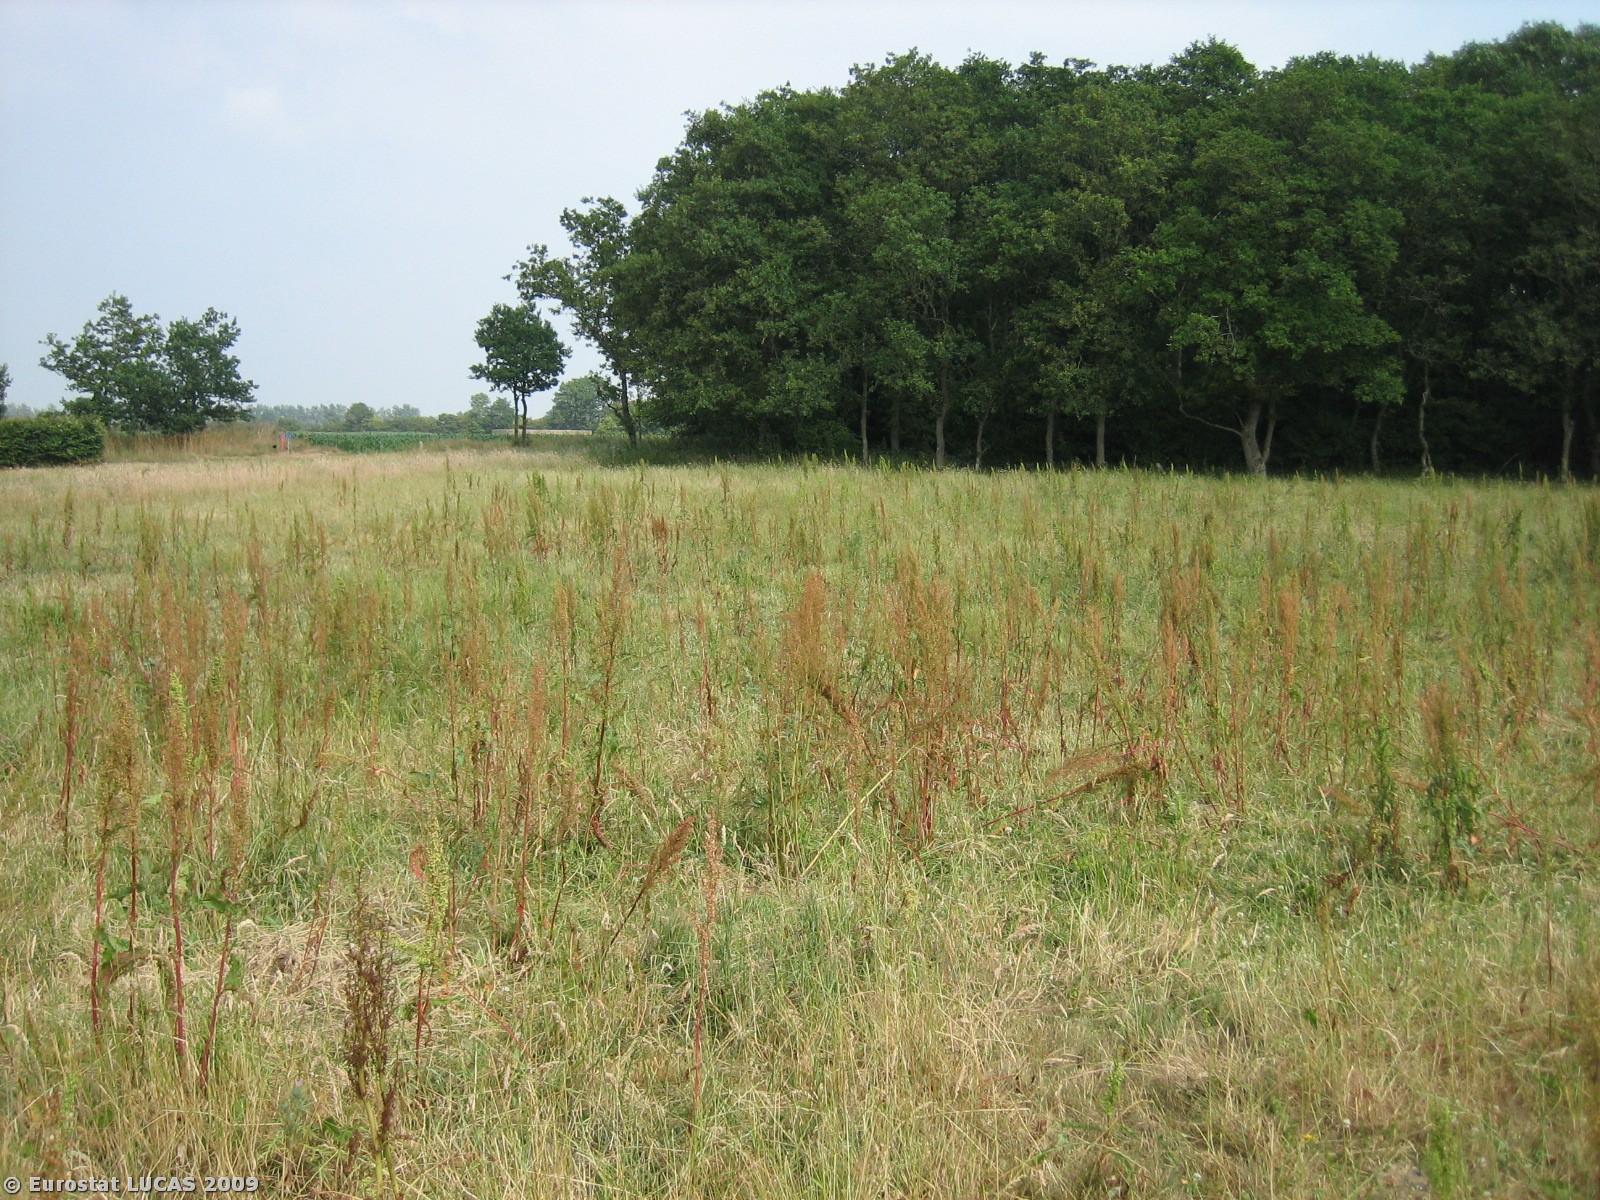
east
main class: Grassland
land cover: Grassland without tree/shrub cover
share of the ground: > 75 %
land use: Agriculture (excluding fallow land and kitchen gardens)
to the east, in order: Grassland without tree/shrub cover; Fences; Broadleaved woodland; Grass margins; Paved roads, cycling and walking lanes; Grass margins; Maize
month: July
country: DK
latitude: 55.5710
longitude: 8.8117
